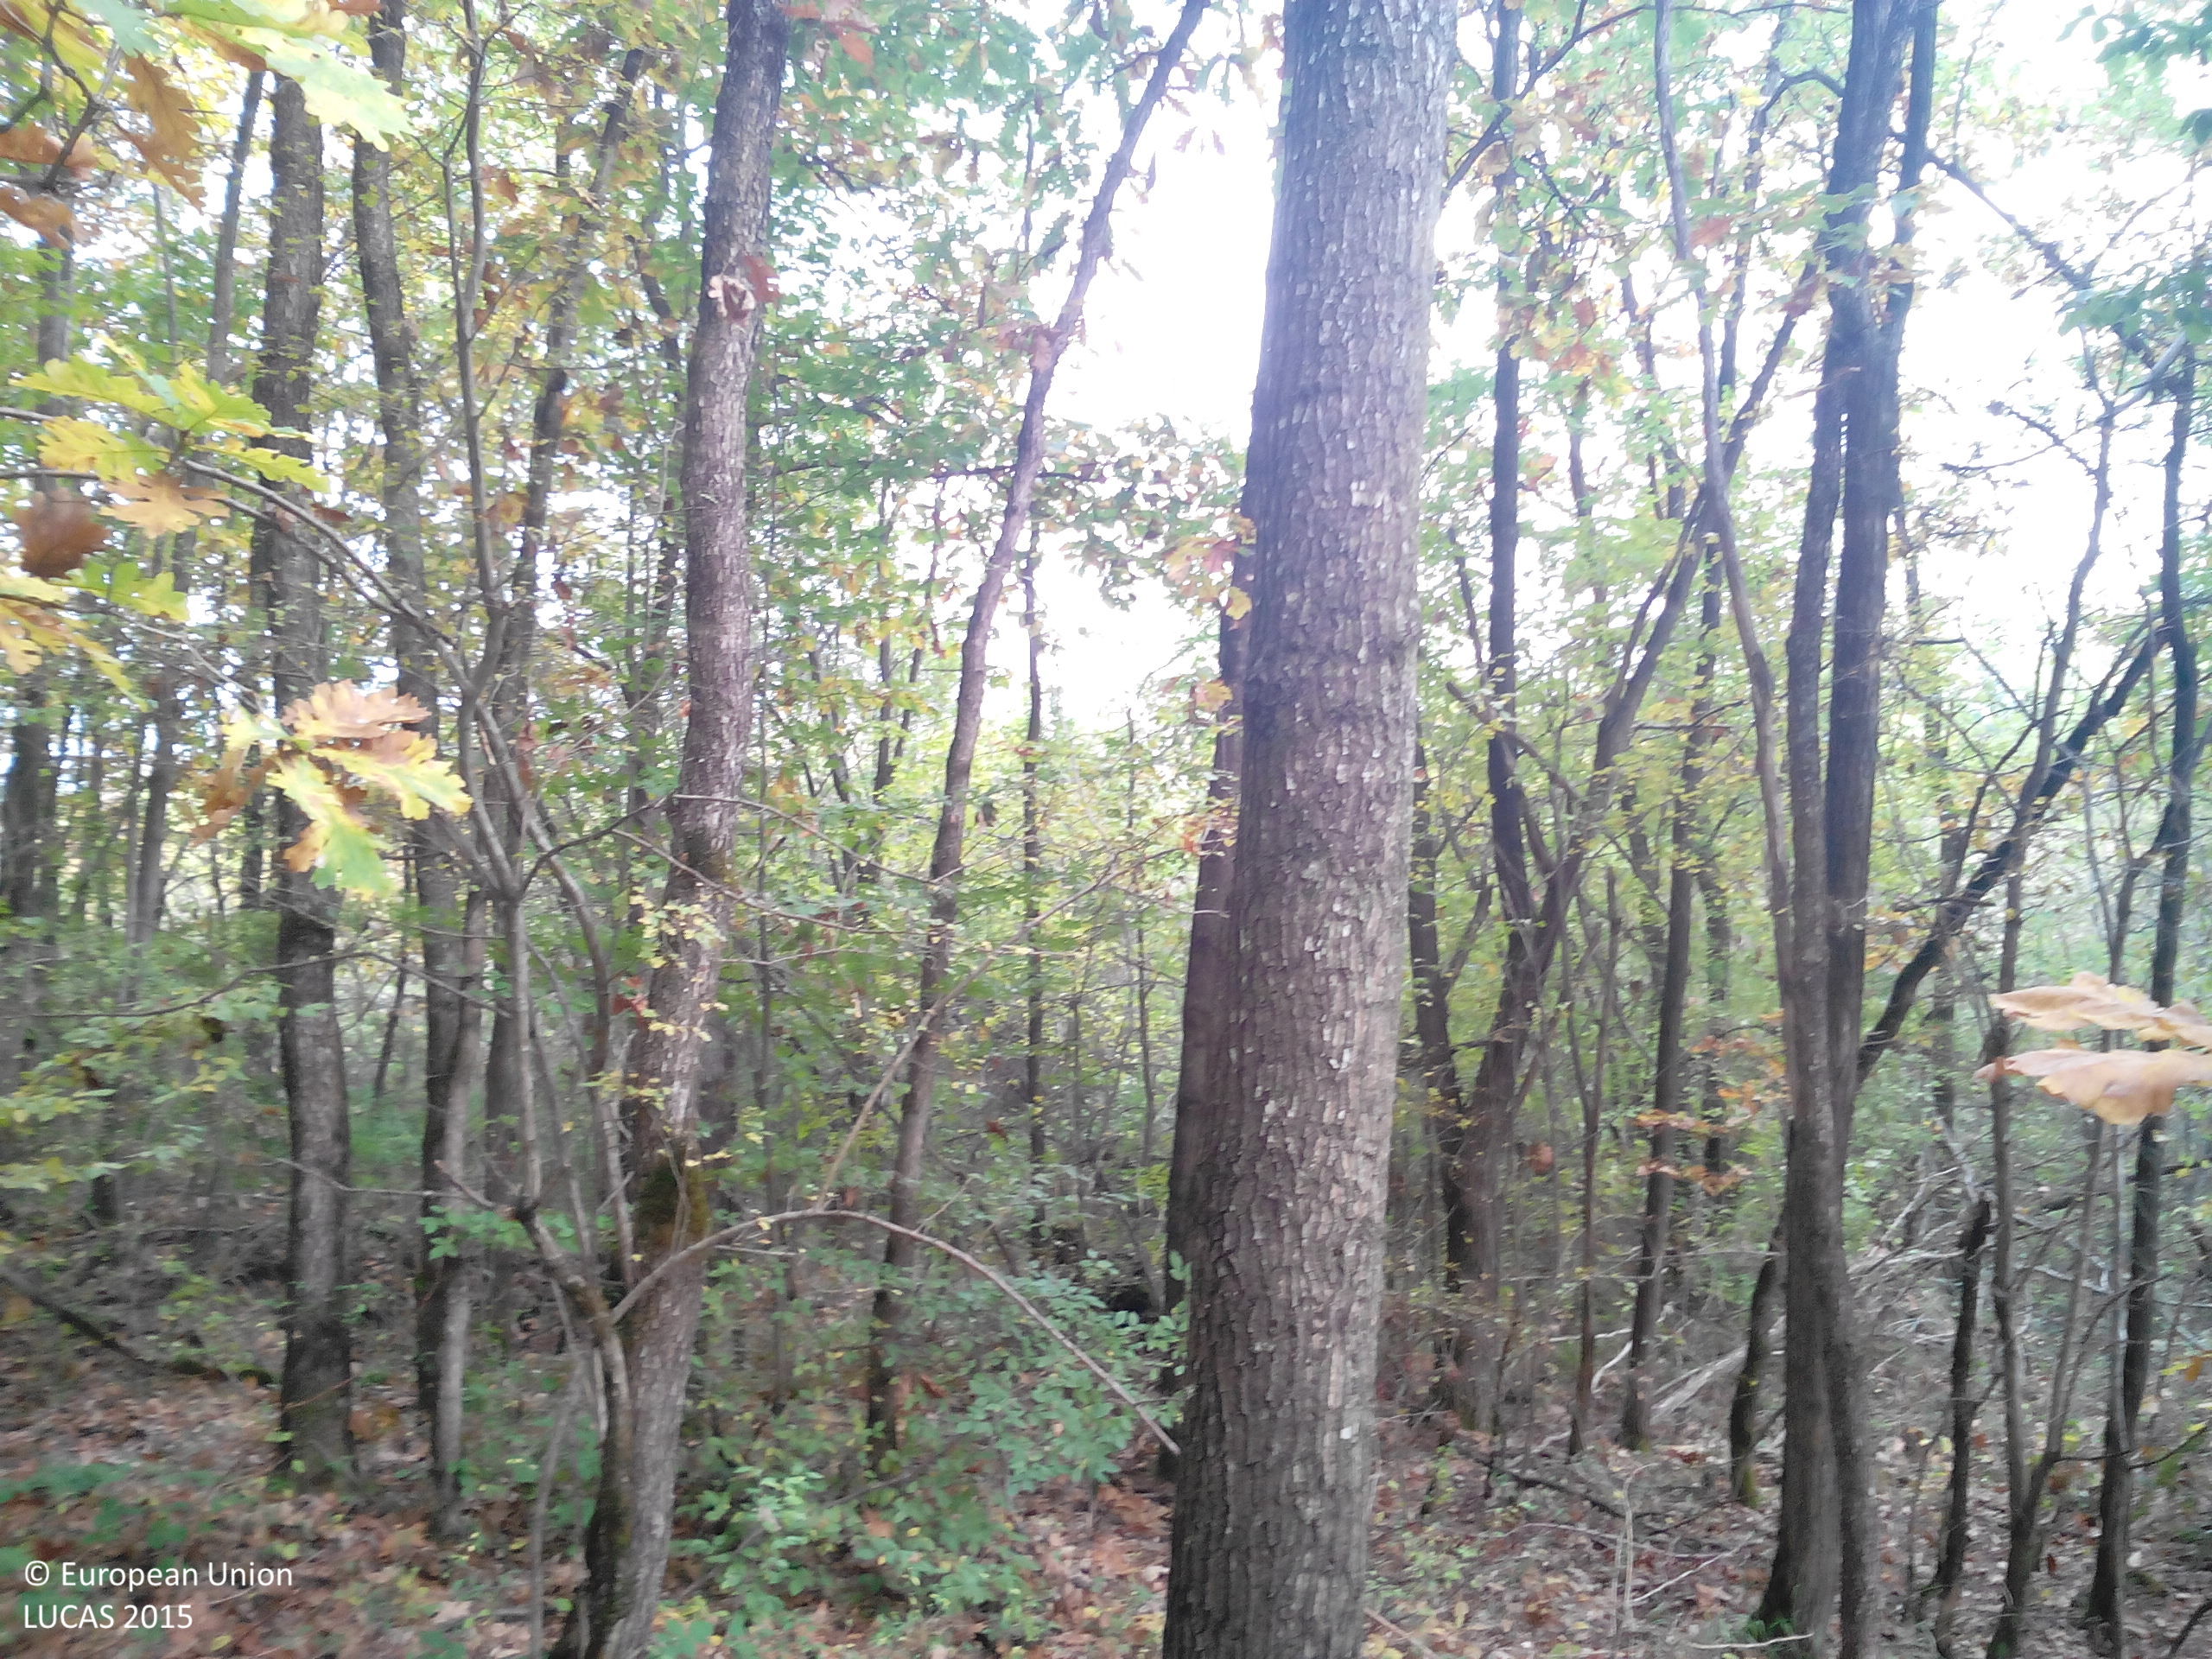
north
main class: Woodland
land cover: Broadleaved woodland
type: acidophilous oak and oak-birch forest
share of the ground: > 75 %
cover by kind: broadleaved forest trees 95 %, shrubs 5 %
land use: Forestry
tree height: > 5 m
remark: Clear cut
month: October
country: BG
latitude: 42.9558
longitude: 24.0093
